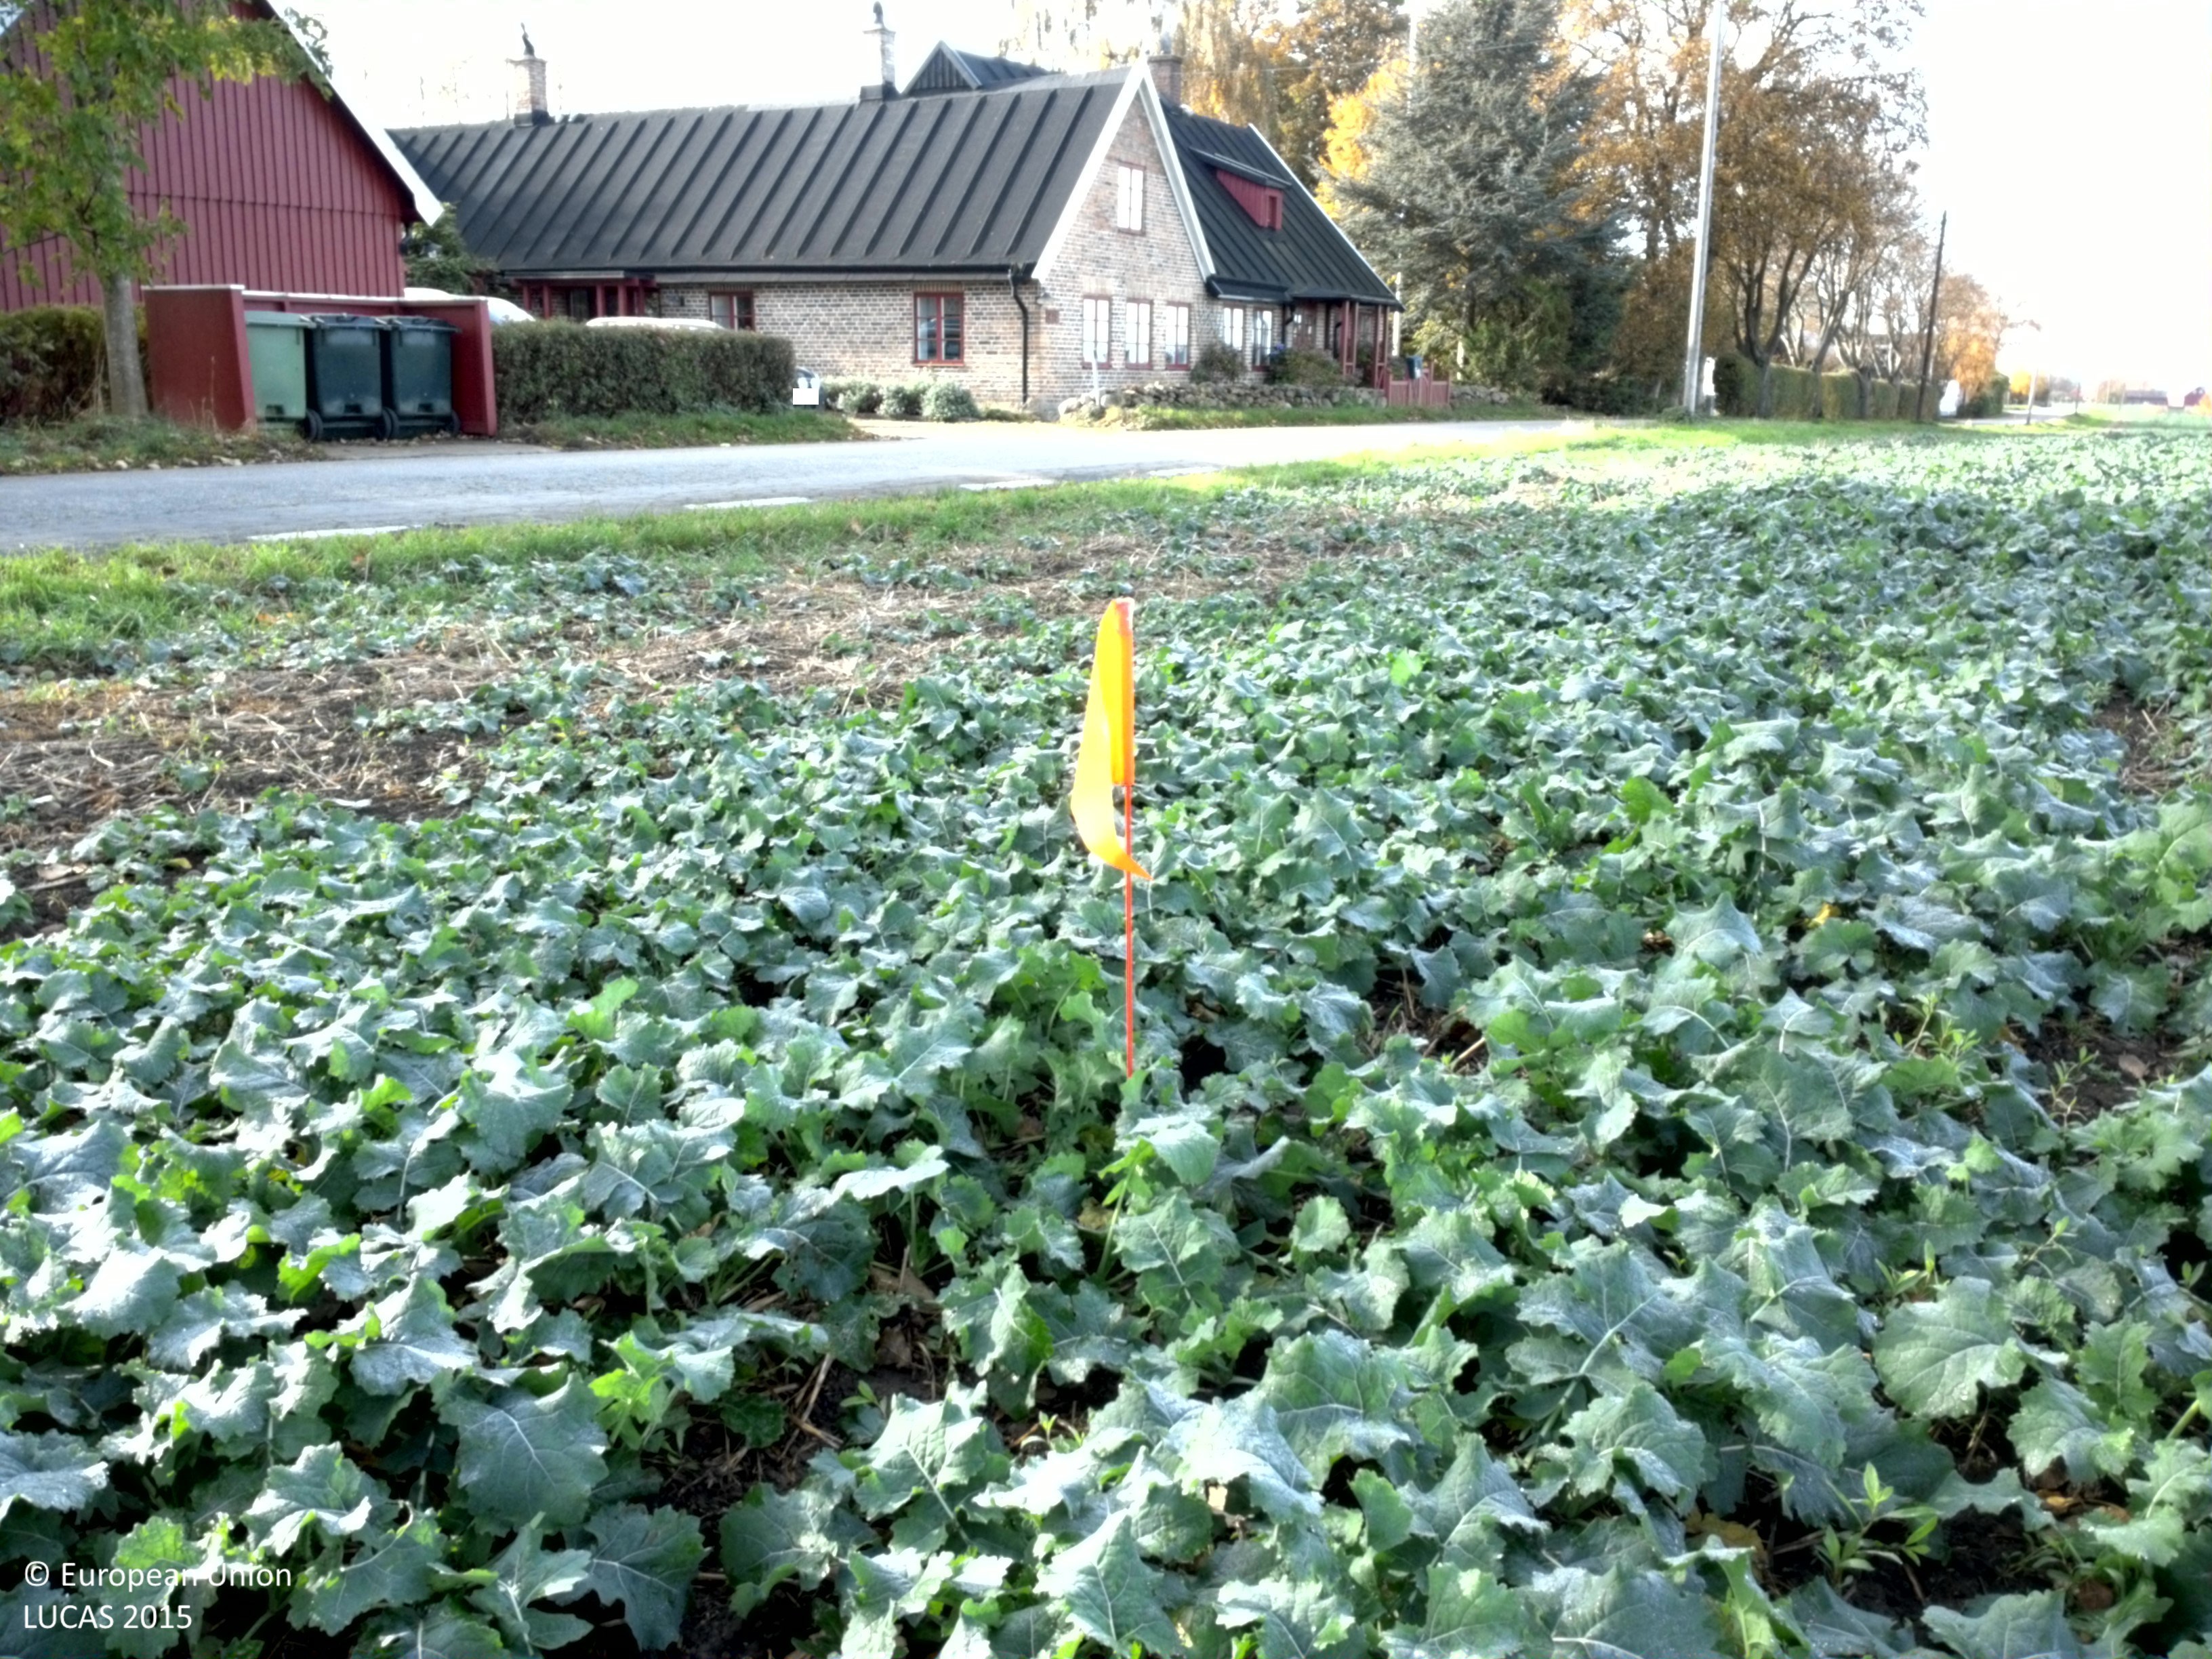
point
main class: Cropland
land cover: Rape and turnip rape
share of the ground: 50 - 75 %
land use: Agriculture (excluding fallow land and kitchen gardens)
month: October
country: SE
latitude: 55.9587
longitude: 12.8328
